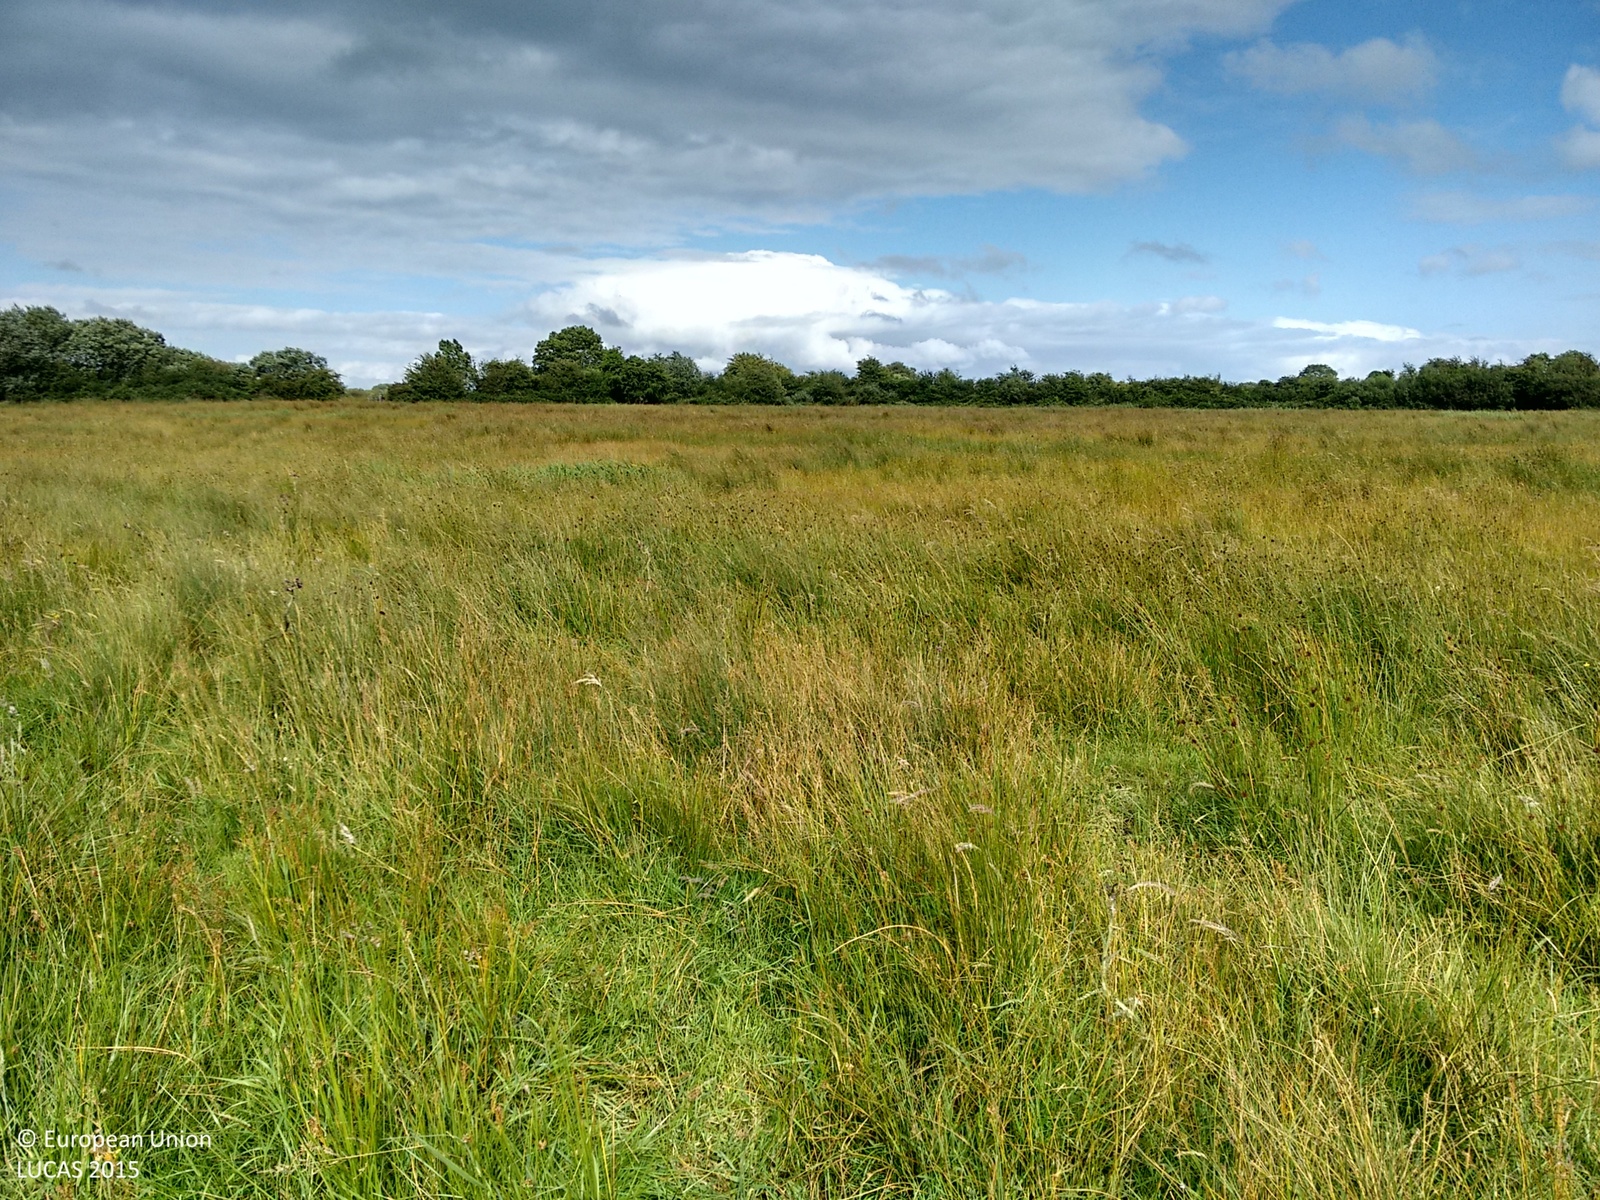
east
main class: Woodland
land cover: Pine dominated coniferous woodland
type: exotic forest
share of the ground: > 75 %
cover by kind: coniferous forest trees 90 %, broadleaved forest trees 5 %, shrubs 5 %
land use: Forestry
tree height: > 5 m
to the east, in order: Pine dominated coniferous woodland; Shrubland with sparse tree cover; Rivers and streams; Fences; Grassland without tree/shrub cover; Managed hedges; Grassland without tree/shrub cover
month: July
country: IE
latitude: 53.6240
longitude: -7.7504
